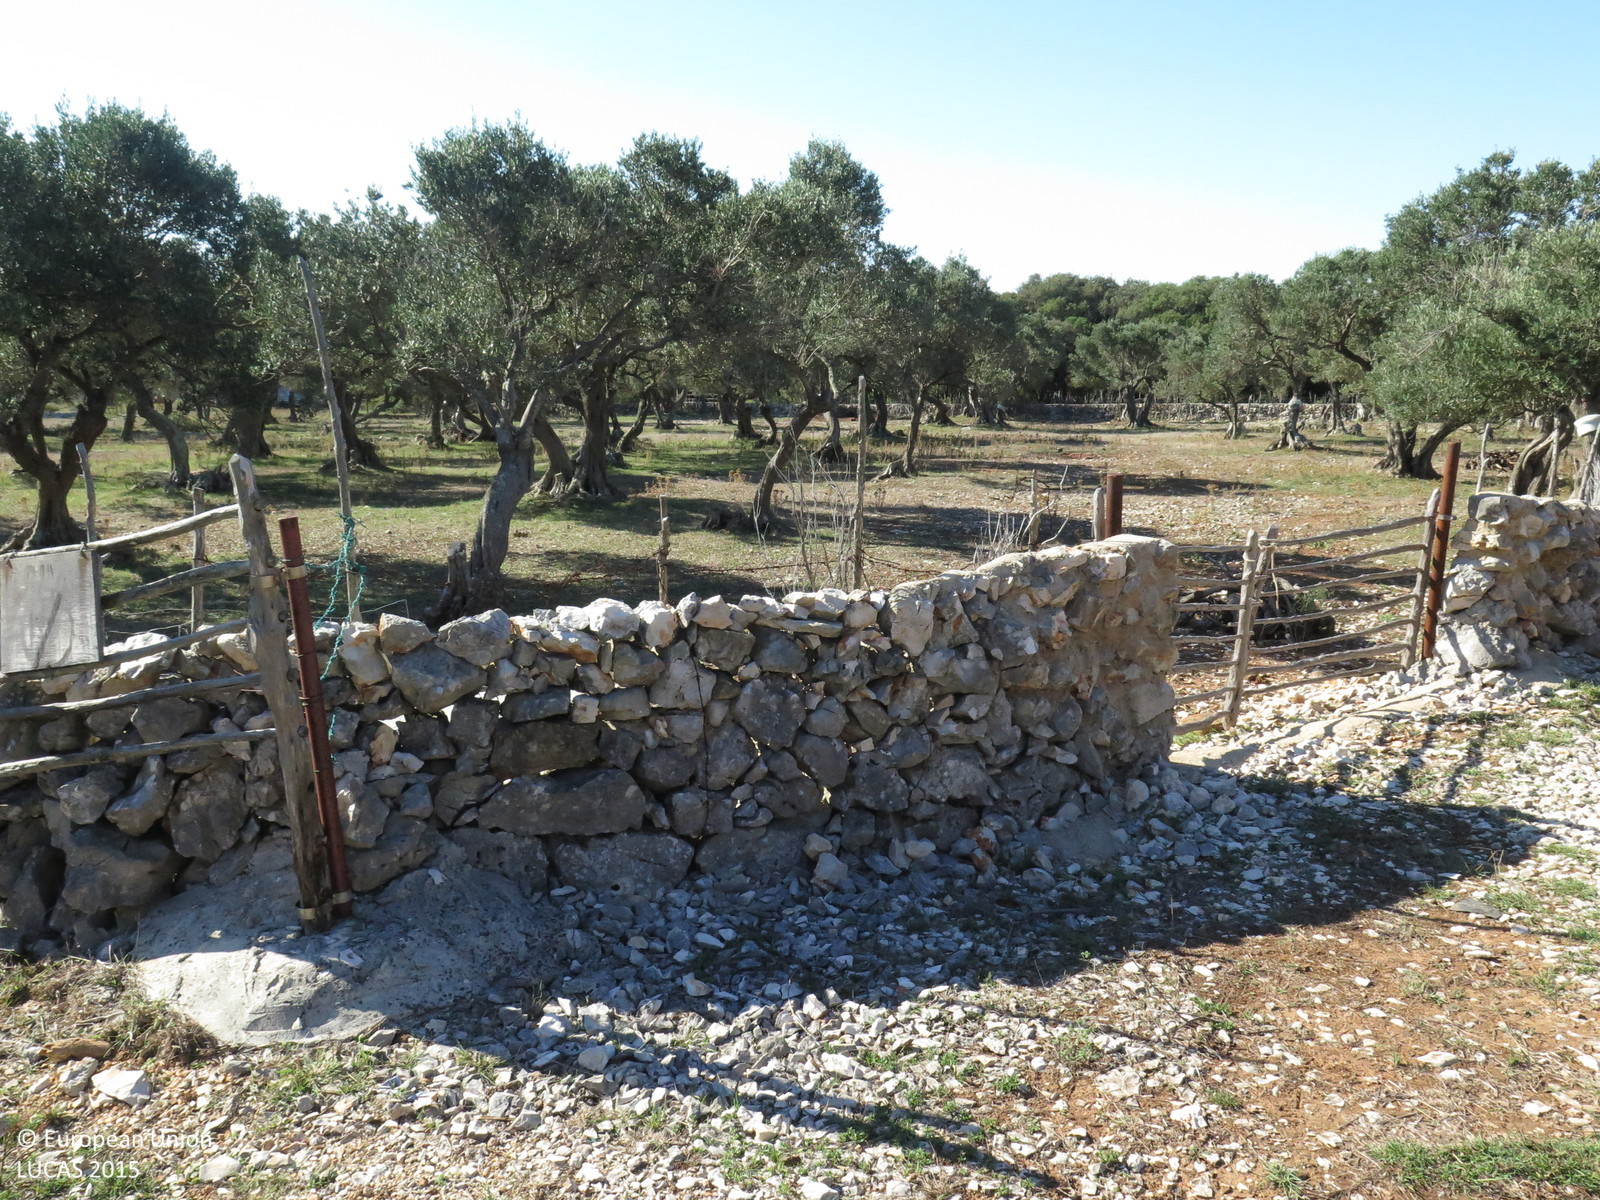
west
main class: Cropland
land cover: Olive groves
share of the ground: 25 - 50 %
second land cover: Grassland without tree/shrub cover
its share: > 75 %
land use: Agriculture (excluding fallow land and kitchen gardens)
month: September
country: HR
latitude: 44.5648
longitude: 14.3874
